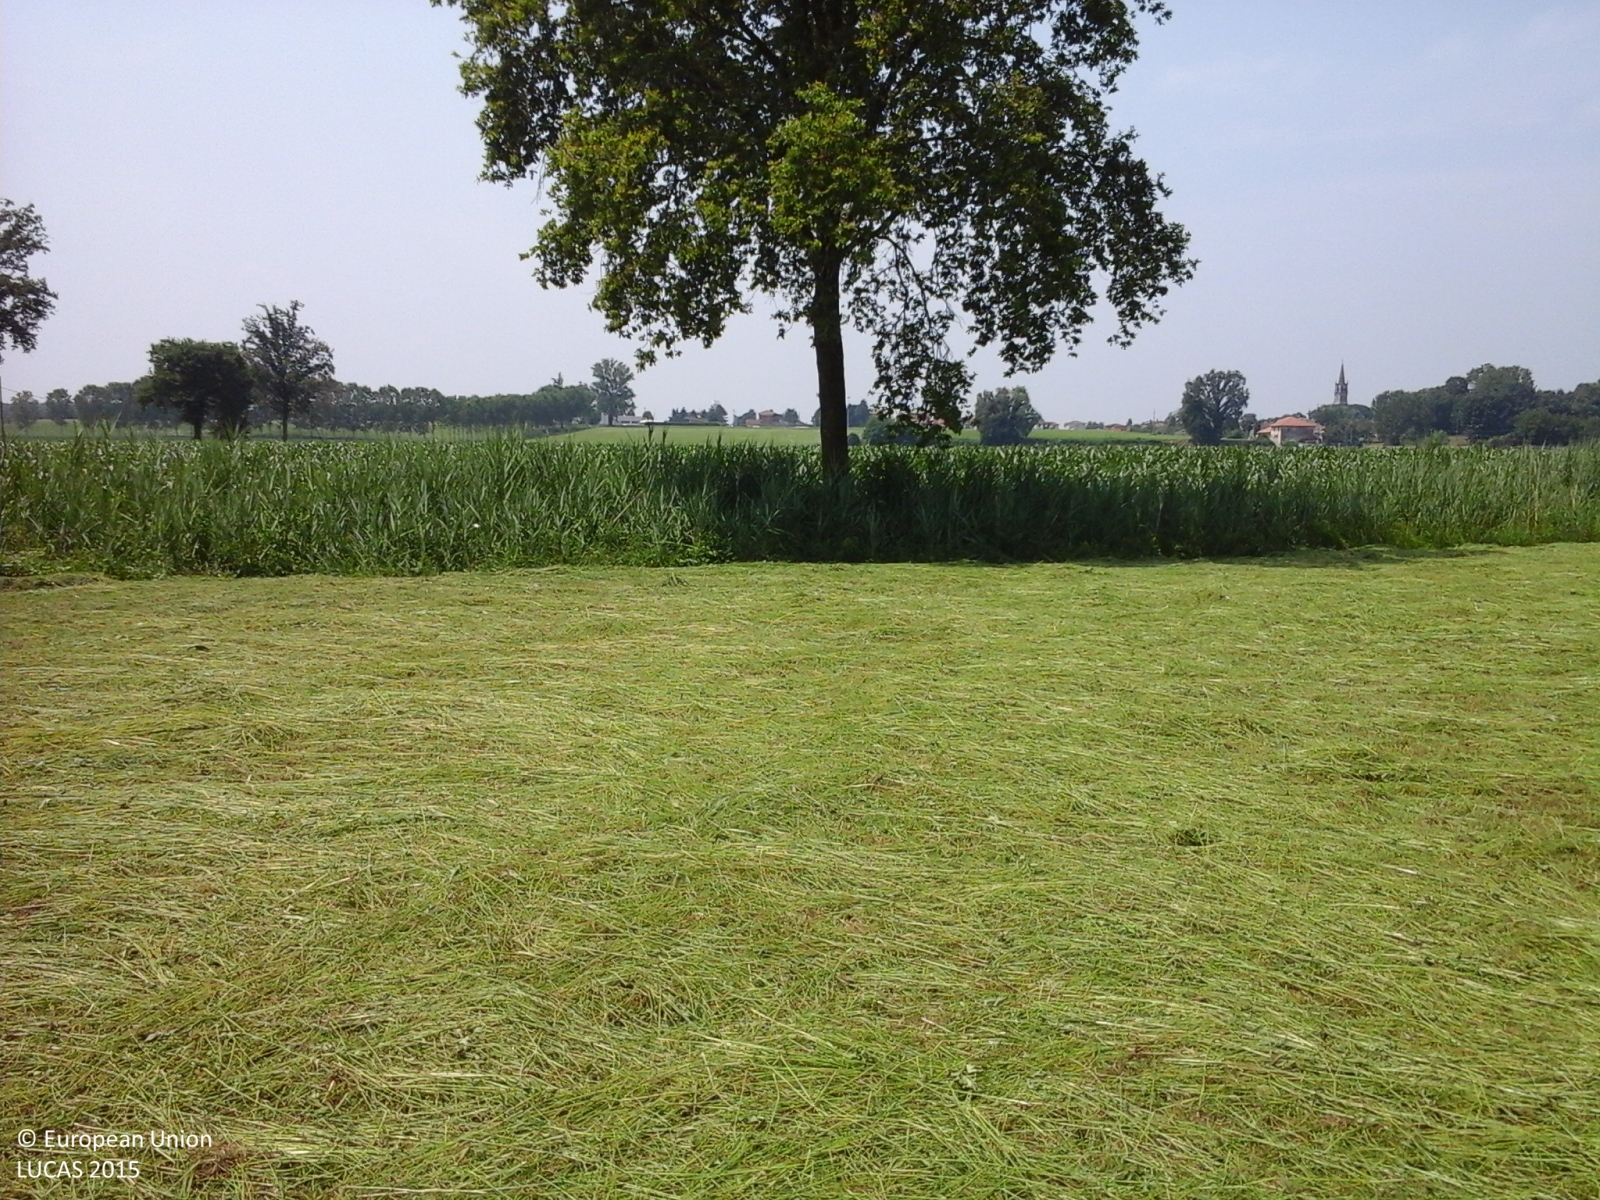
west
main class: Grassland
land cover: Grassland without tree/shrub cover
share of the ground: > 75 %
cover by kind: herbaceous plants 100 %
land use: Agriculture (excluding fallow land and kitchen gardens)
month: June
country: IT
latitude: 45.2336
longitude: 9.6821
